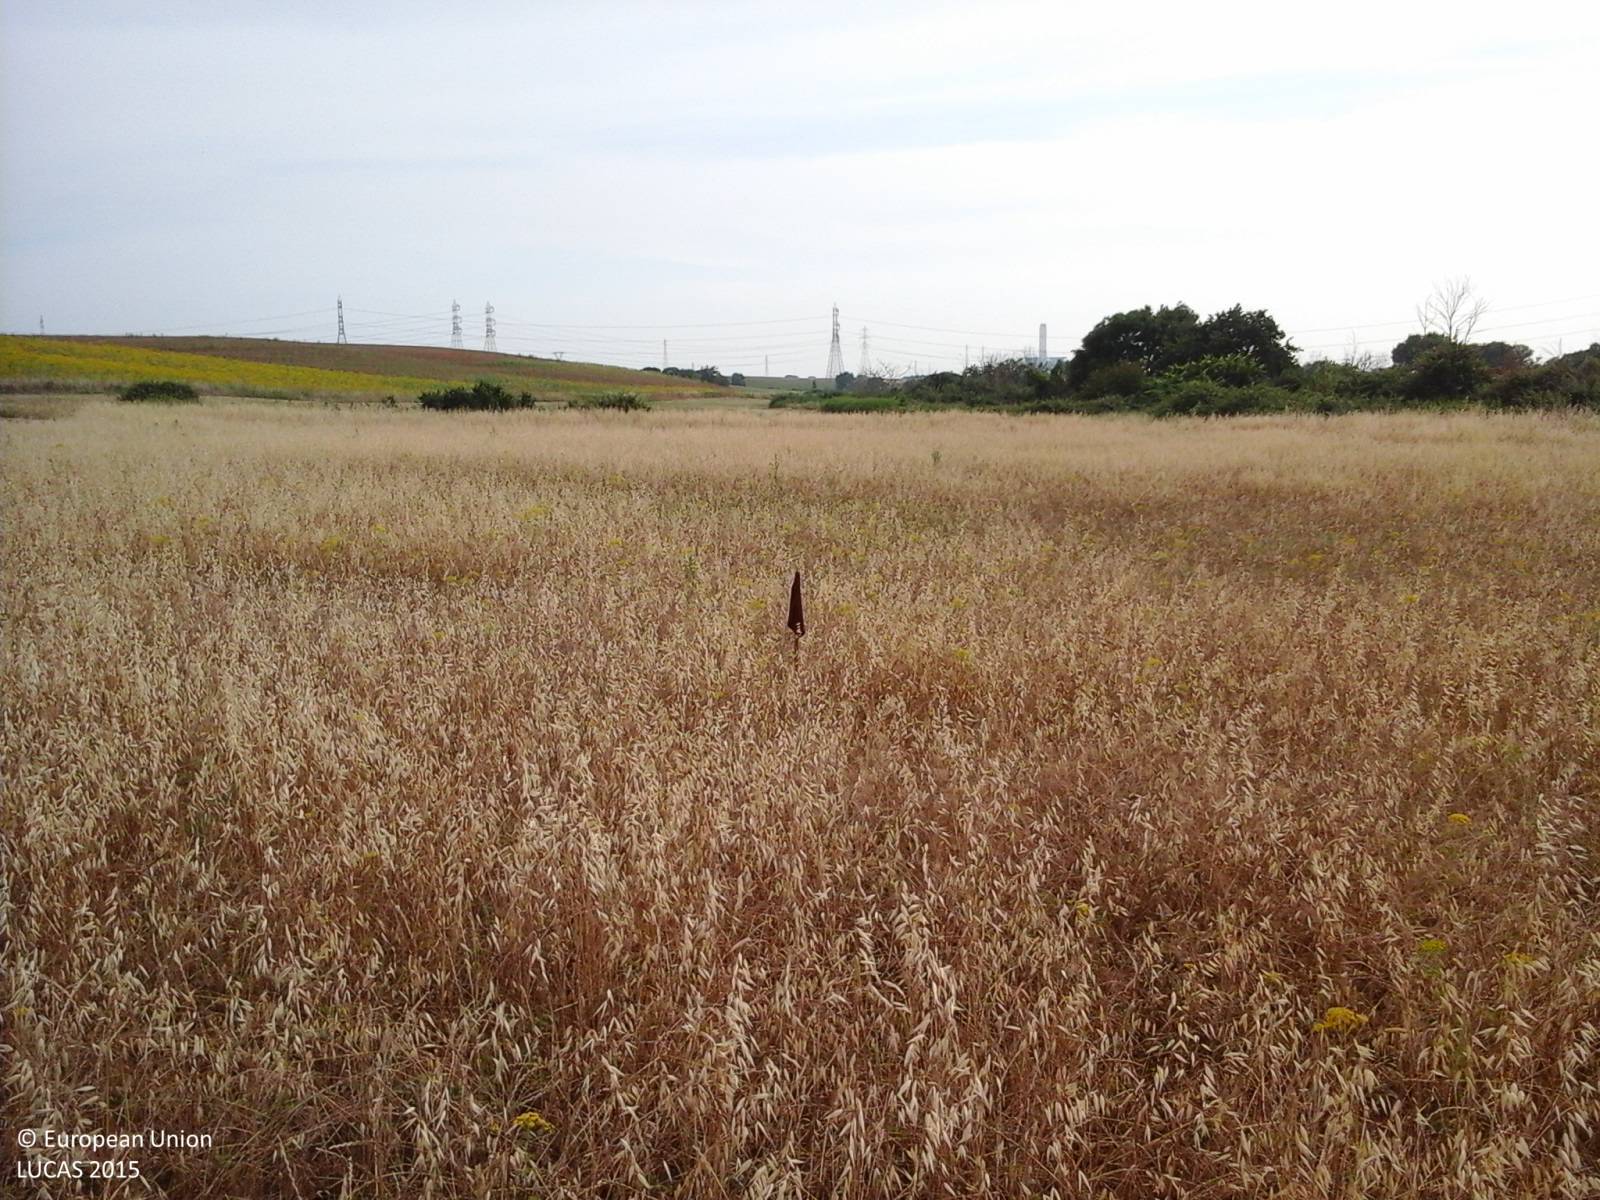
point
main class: Cropland
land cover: Oats
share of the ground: > 75 %
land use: Agriculture (excluding fallow land and kitchen gardens)
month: June
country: IT
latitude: 42.3887
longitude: 11.5857
